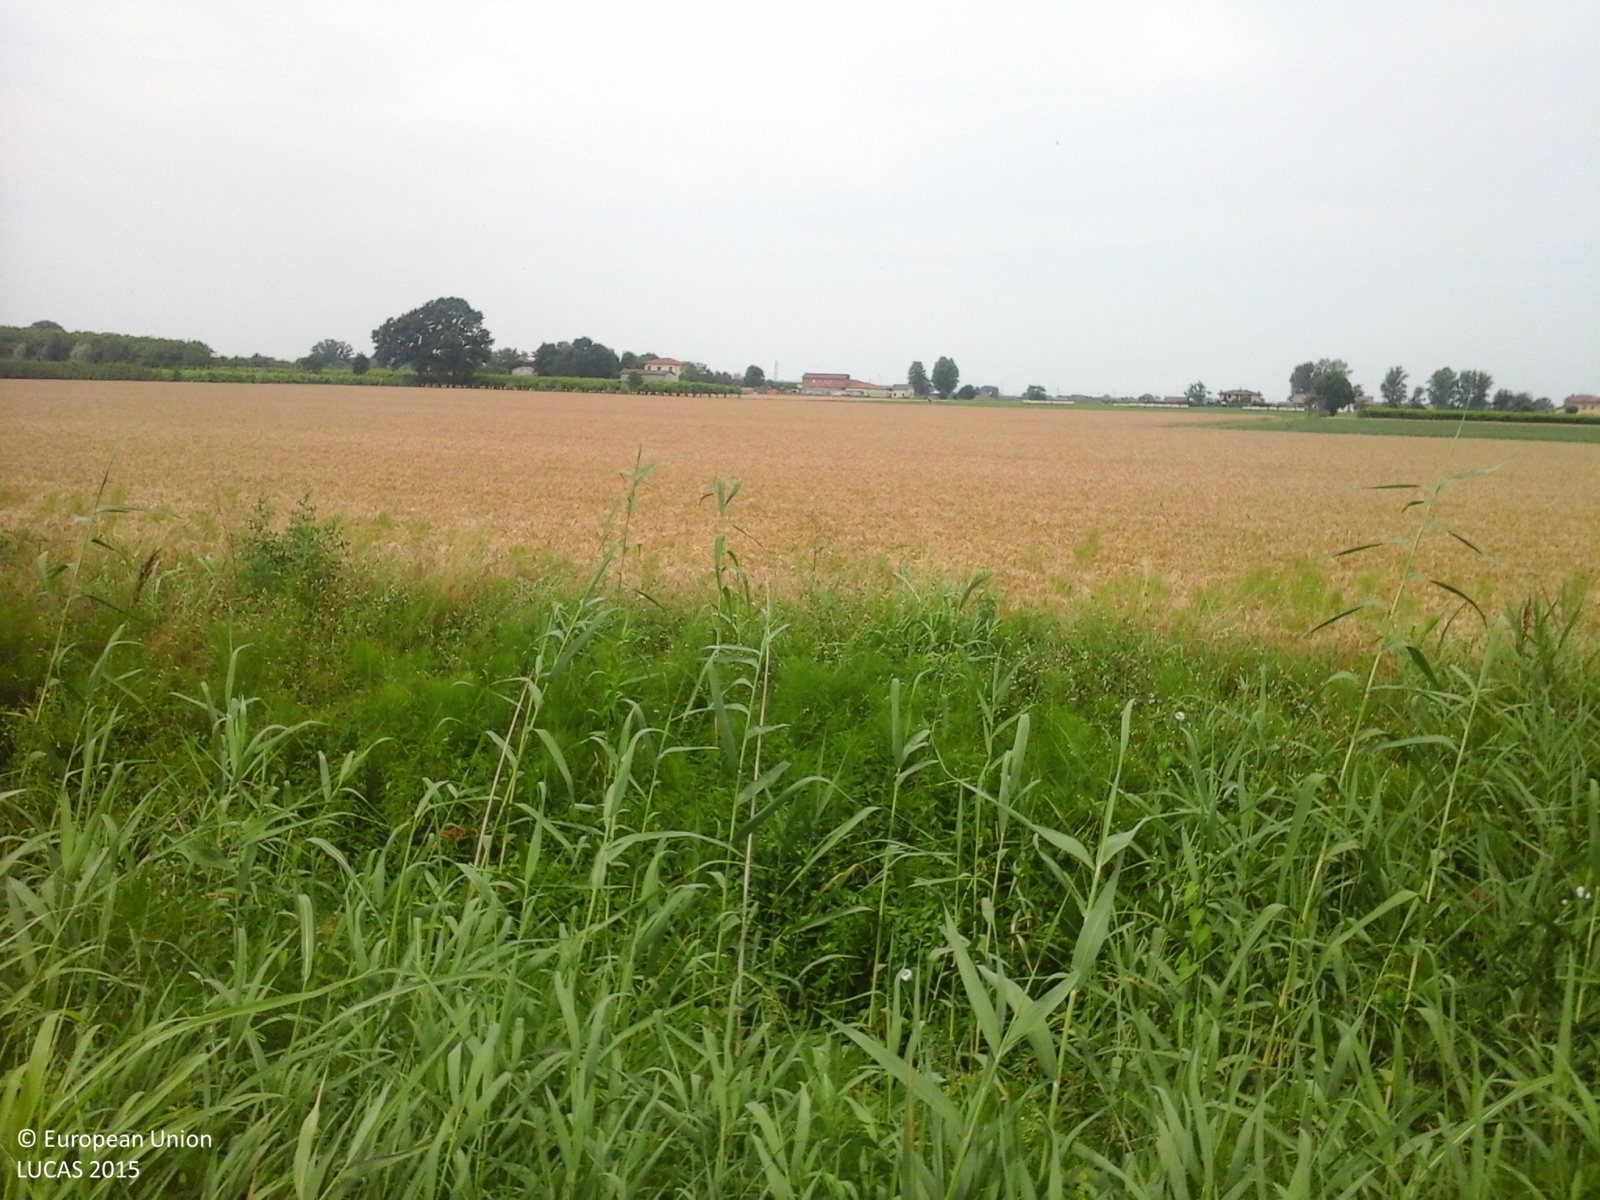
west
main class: Cropland
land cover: Common wheat
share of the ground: > 75 %
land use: Agriculture (excluding fallow land and kitchen gardens)
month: June
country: IT
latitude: 44.6336
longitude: 11.0692
